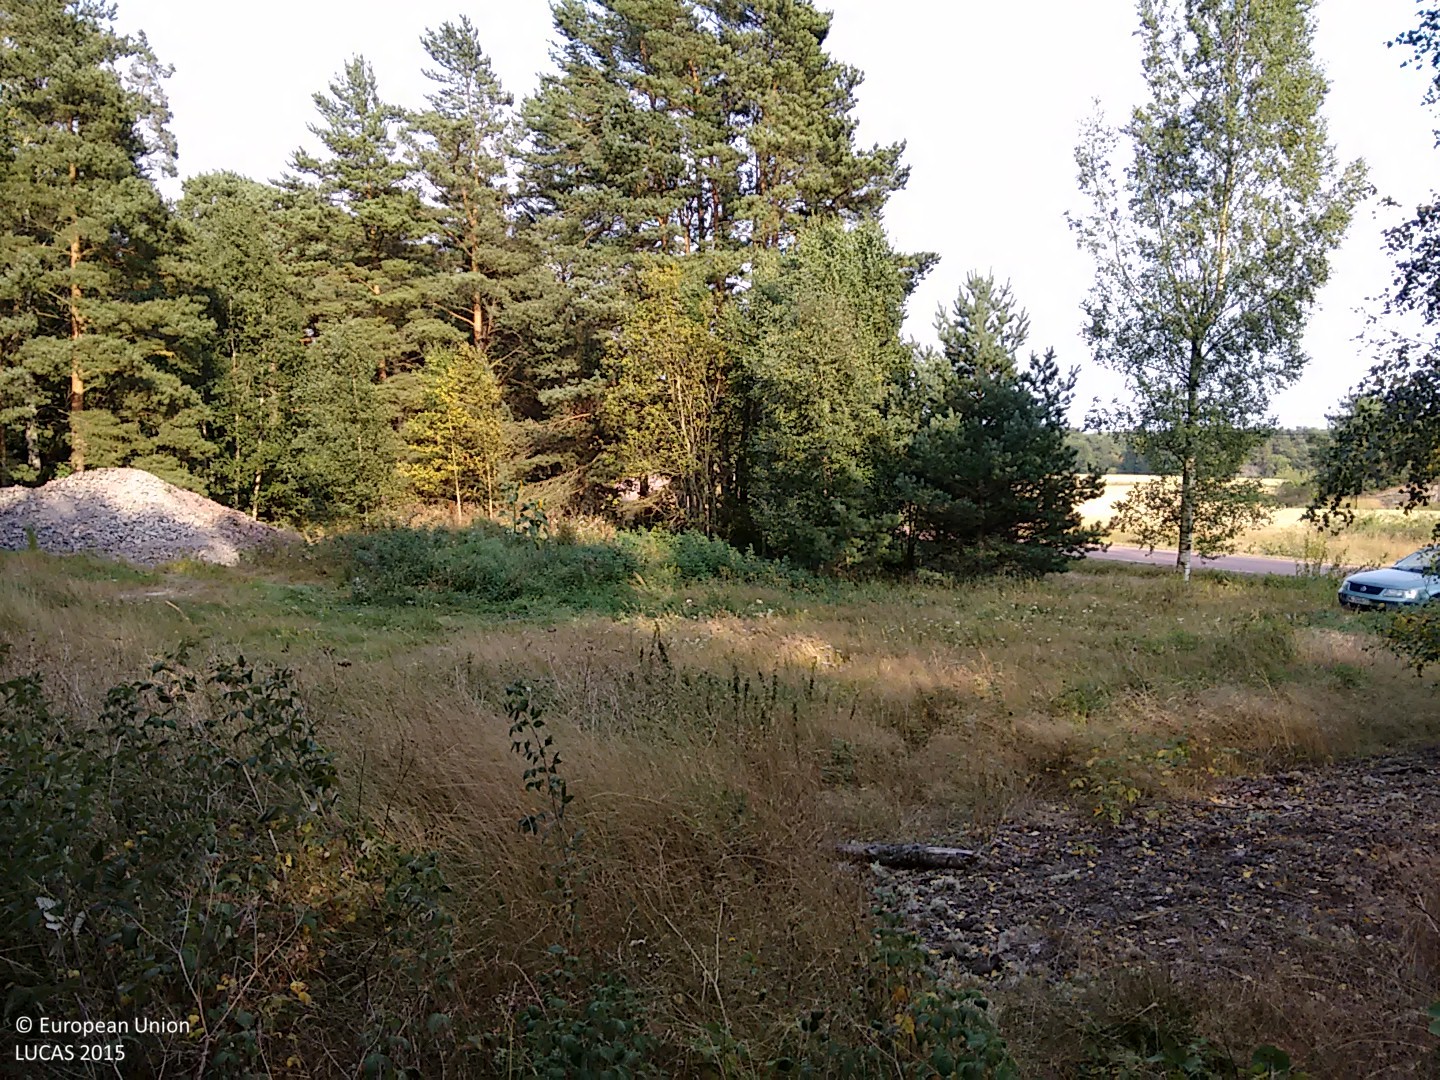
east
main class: Woodland
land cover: Pine dominated mixed woodland
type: hemiboreal forest and nemoral coniferous forest and mixed broadleaved-coniferous forest
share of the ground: > 75 %
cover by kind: coniferous forest trees 65 %, broadleaved forest trees 30 %, herbaceous plants 5 %
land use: Forestry
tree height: > 5 m
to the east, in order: Pine dominated mixed woodland; Grassland without tree/shrub cover; Pine dominated mixed woodland; Grassland without tree/shrub cover; Ditches and canals; Grass margins; Paved roads, cycling and walking lanes; Grassland without tree/shrub cover; Ditches and canals; Shrubland without tree cover; Electric lines; Common wheat; Grass margins; Ditches and canals; Pine dominated mixed woodland; Electric lines; Tracks; Broadleaved woodland; Electric lines; Pine dominated mixed woodland; Grassland without tree/shrub cover; Paved roads, cycling and walking lanes
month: August
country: FI
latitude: 60.0465
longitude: 20.4439
